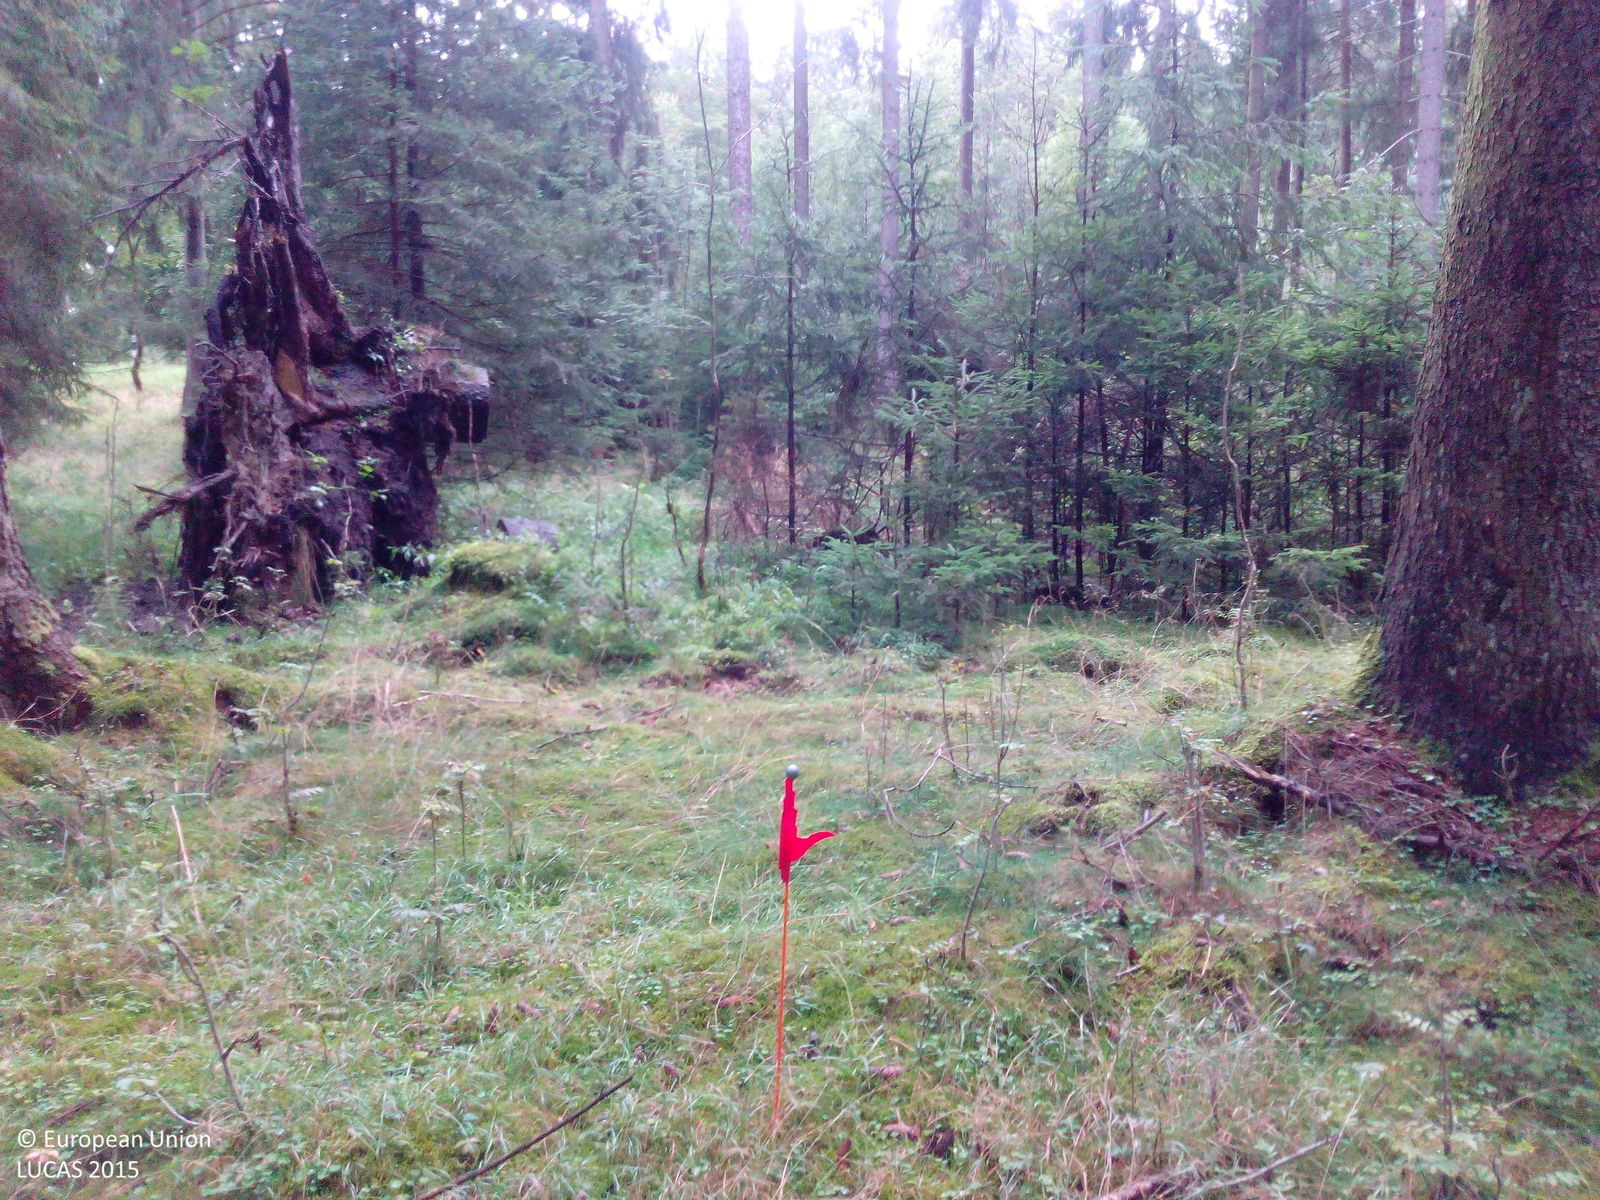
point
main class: Woodland
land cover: Spruce dominated coniferous woodland
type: hemiboreal forest and nemoral coniferous forest and mixed broadleaved-coniferous forest
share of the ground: > 75 %
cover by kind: coniferous forest trees 90 %, herbaceous plants 10 %
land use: Forestry
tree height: > 5 m
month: August
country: DE
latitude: 51.7107
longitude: 10.6221
